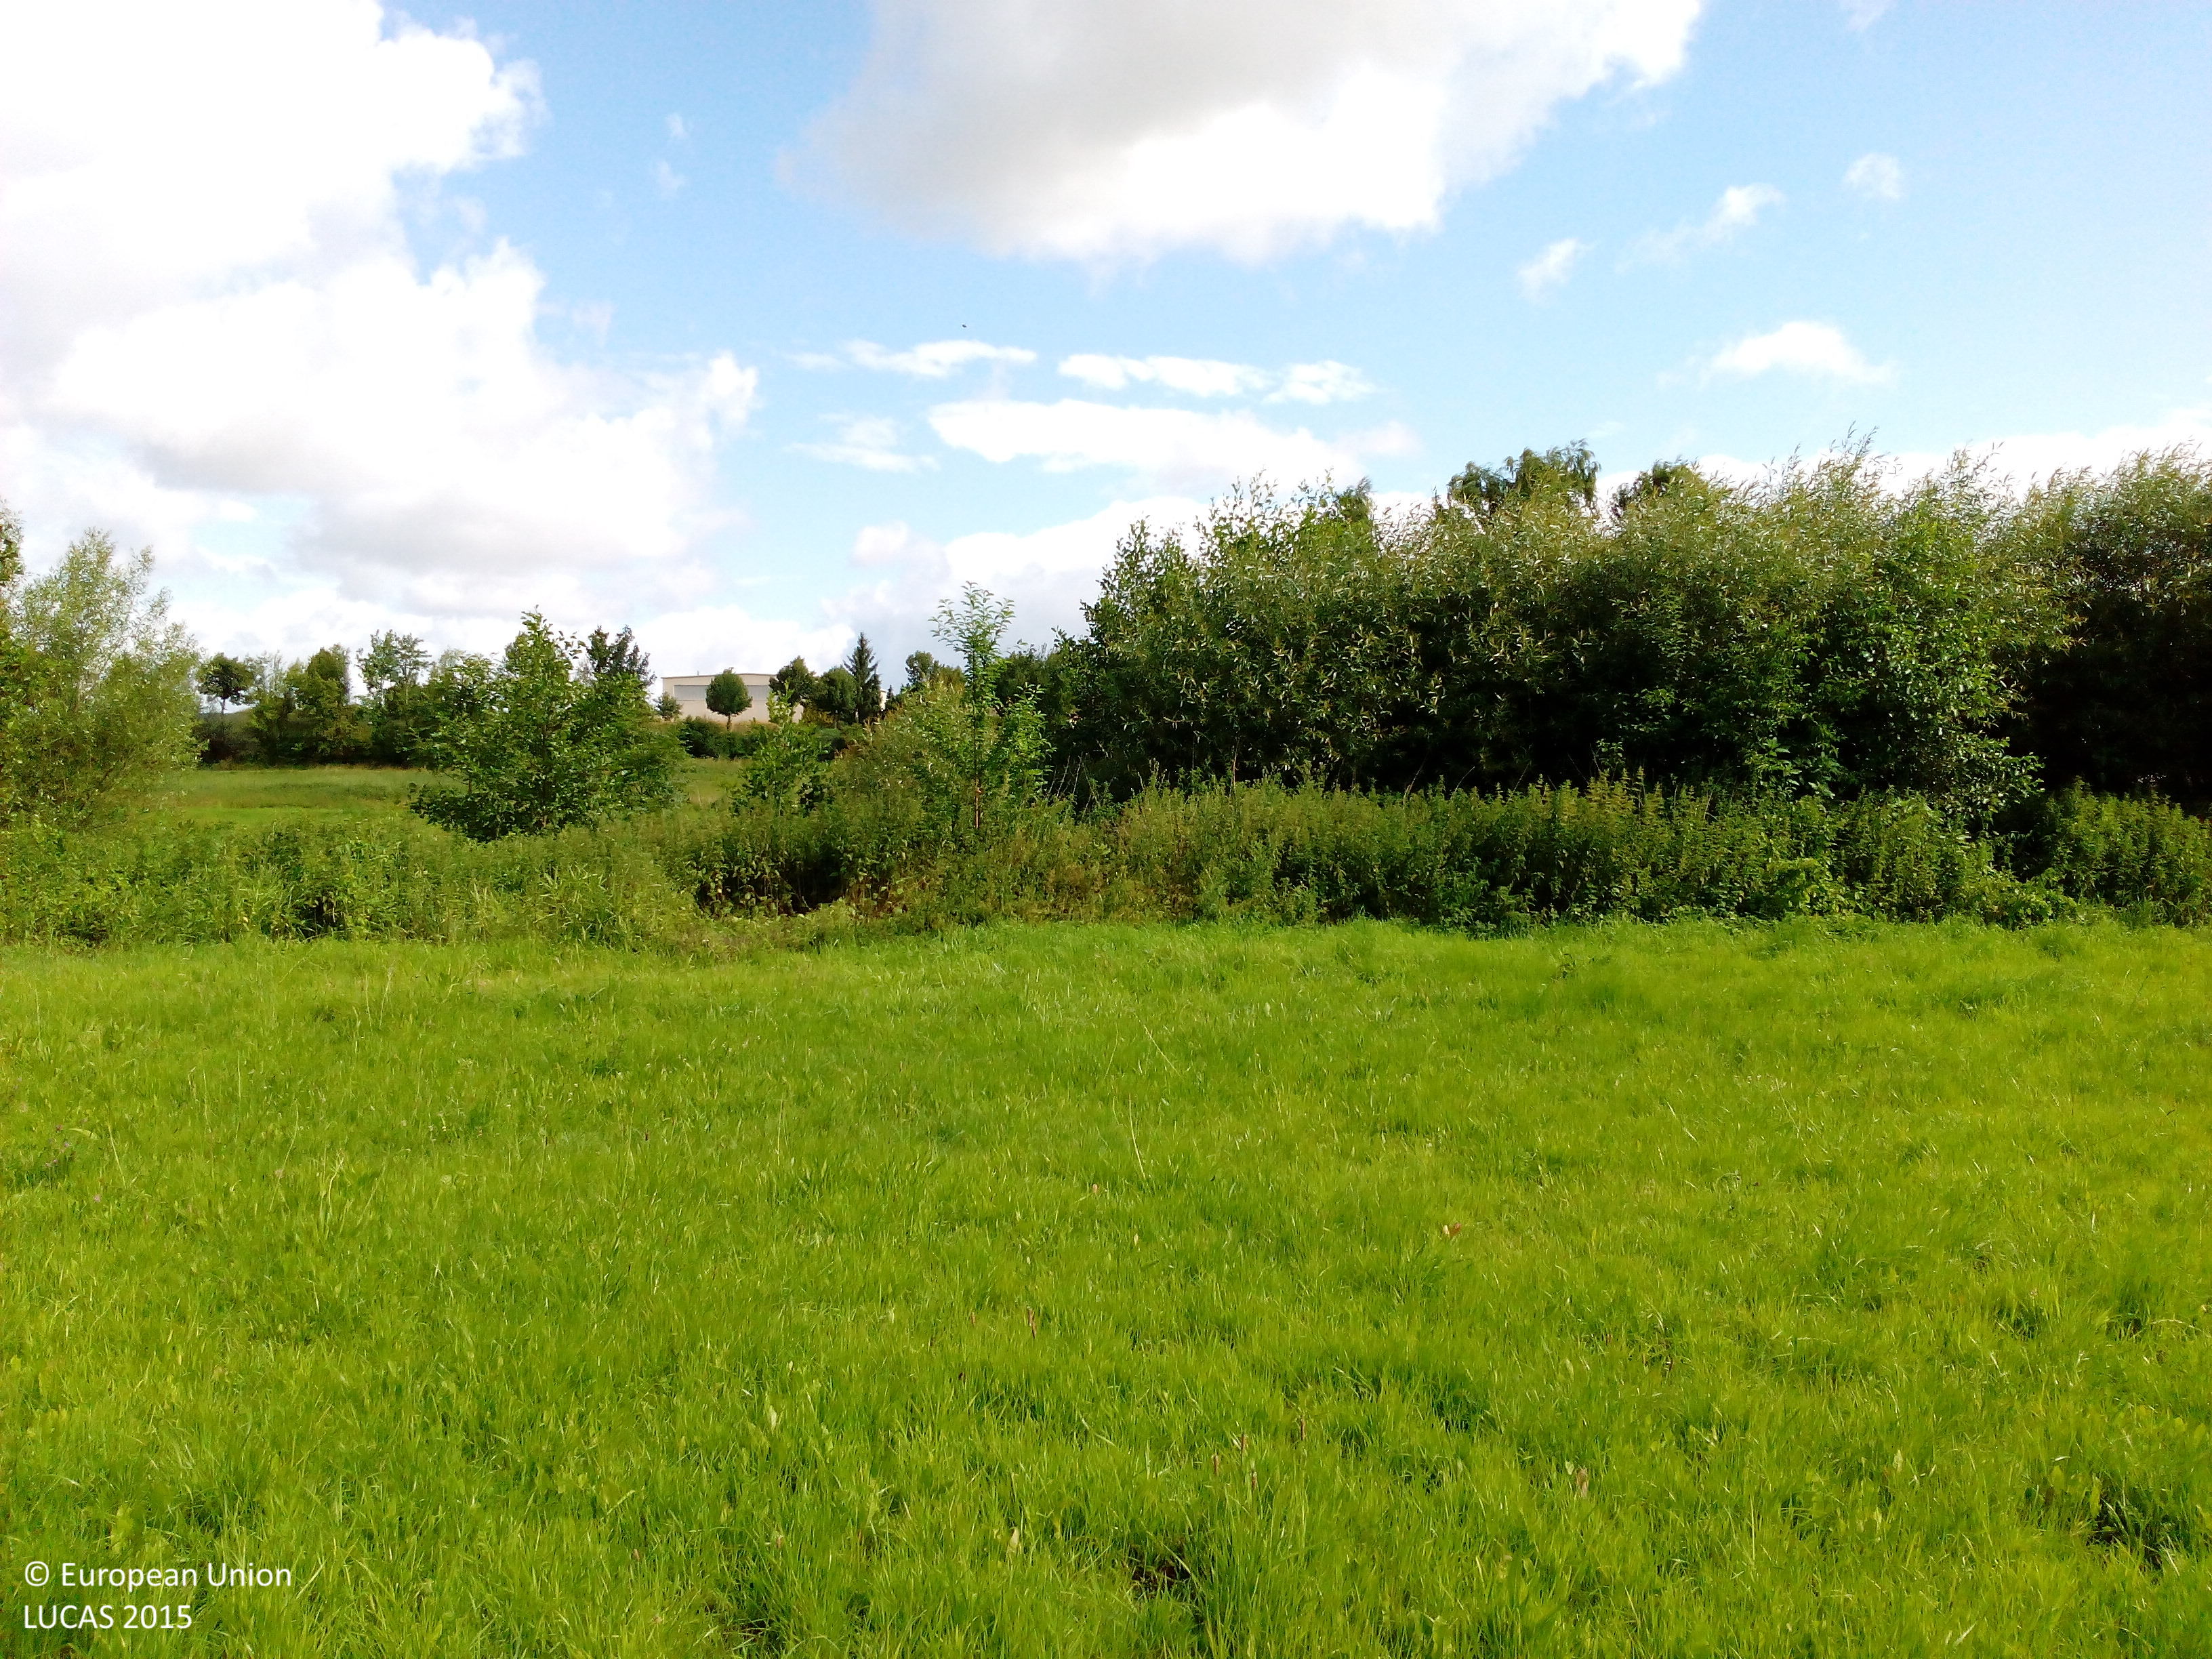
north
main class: Grassland
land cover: Grassland without tree/shrub cover
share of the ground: > 75 %
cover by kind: herbaceous plants 100 %
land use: Agriculture (excluding fallow land and kitchen gardens)
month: July
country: DE
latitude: 51.6404
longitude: 9.8700
